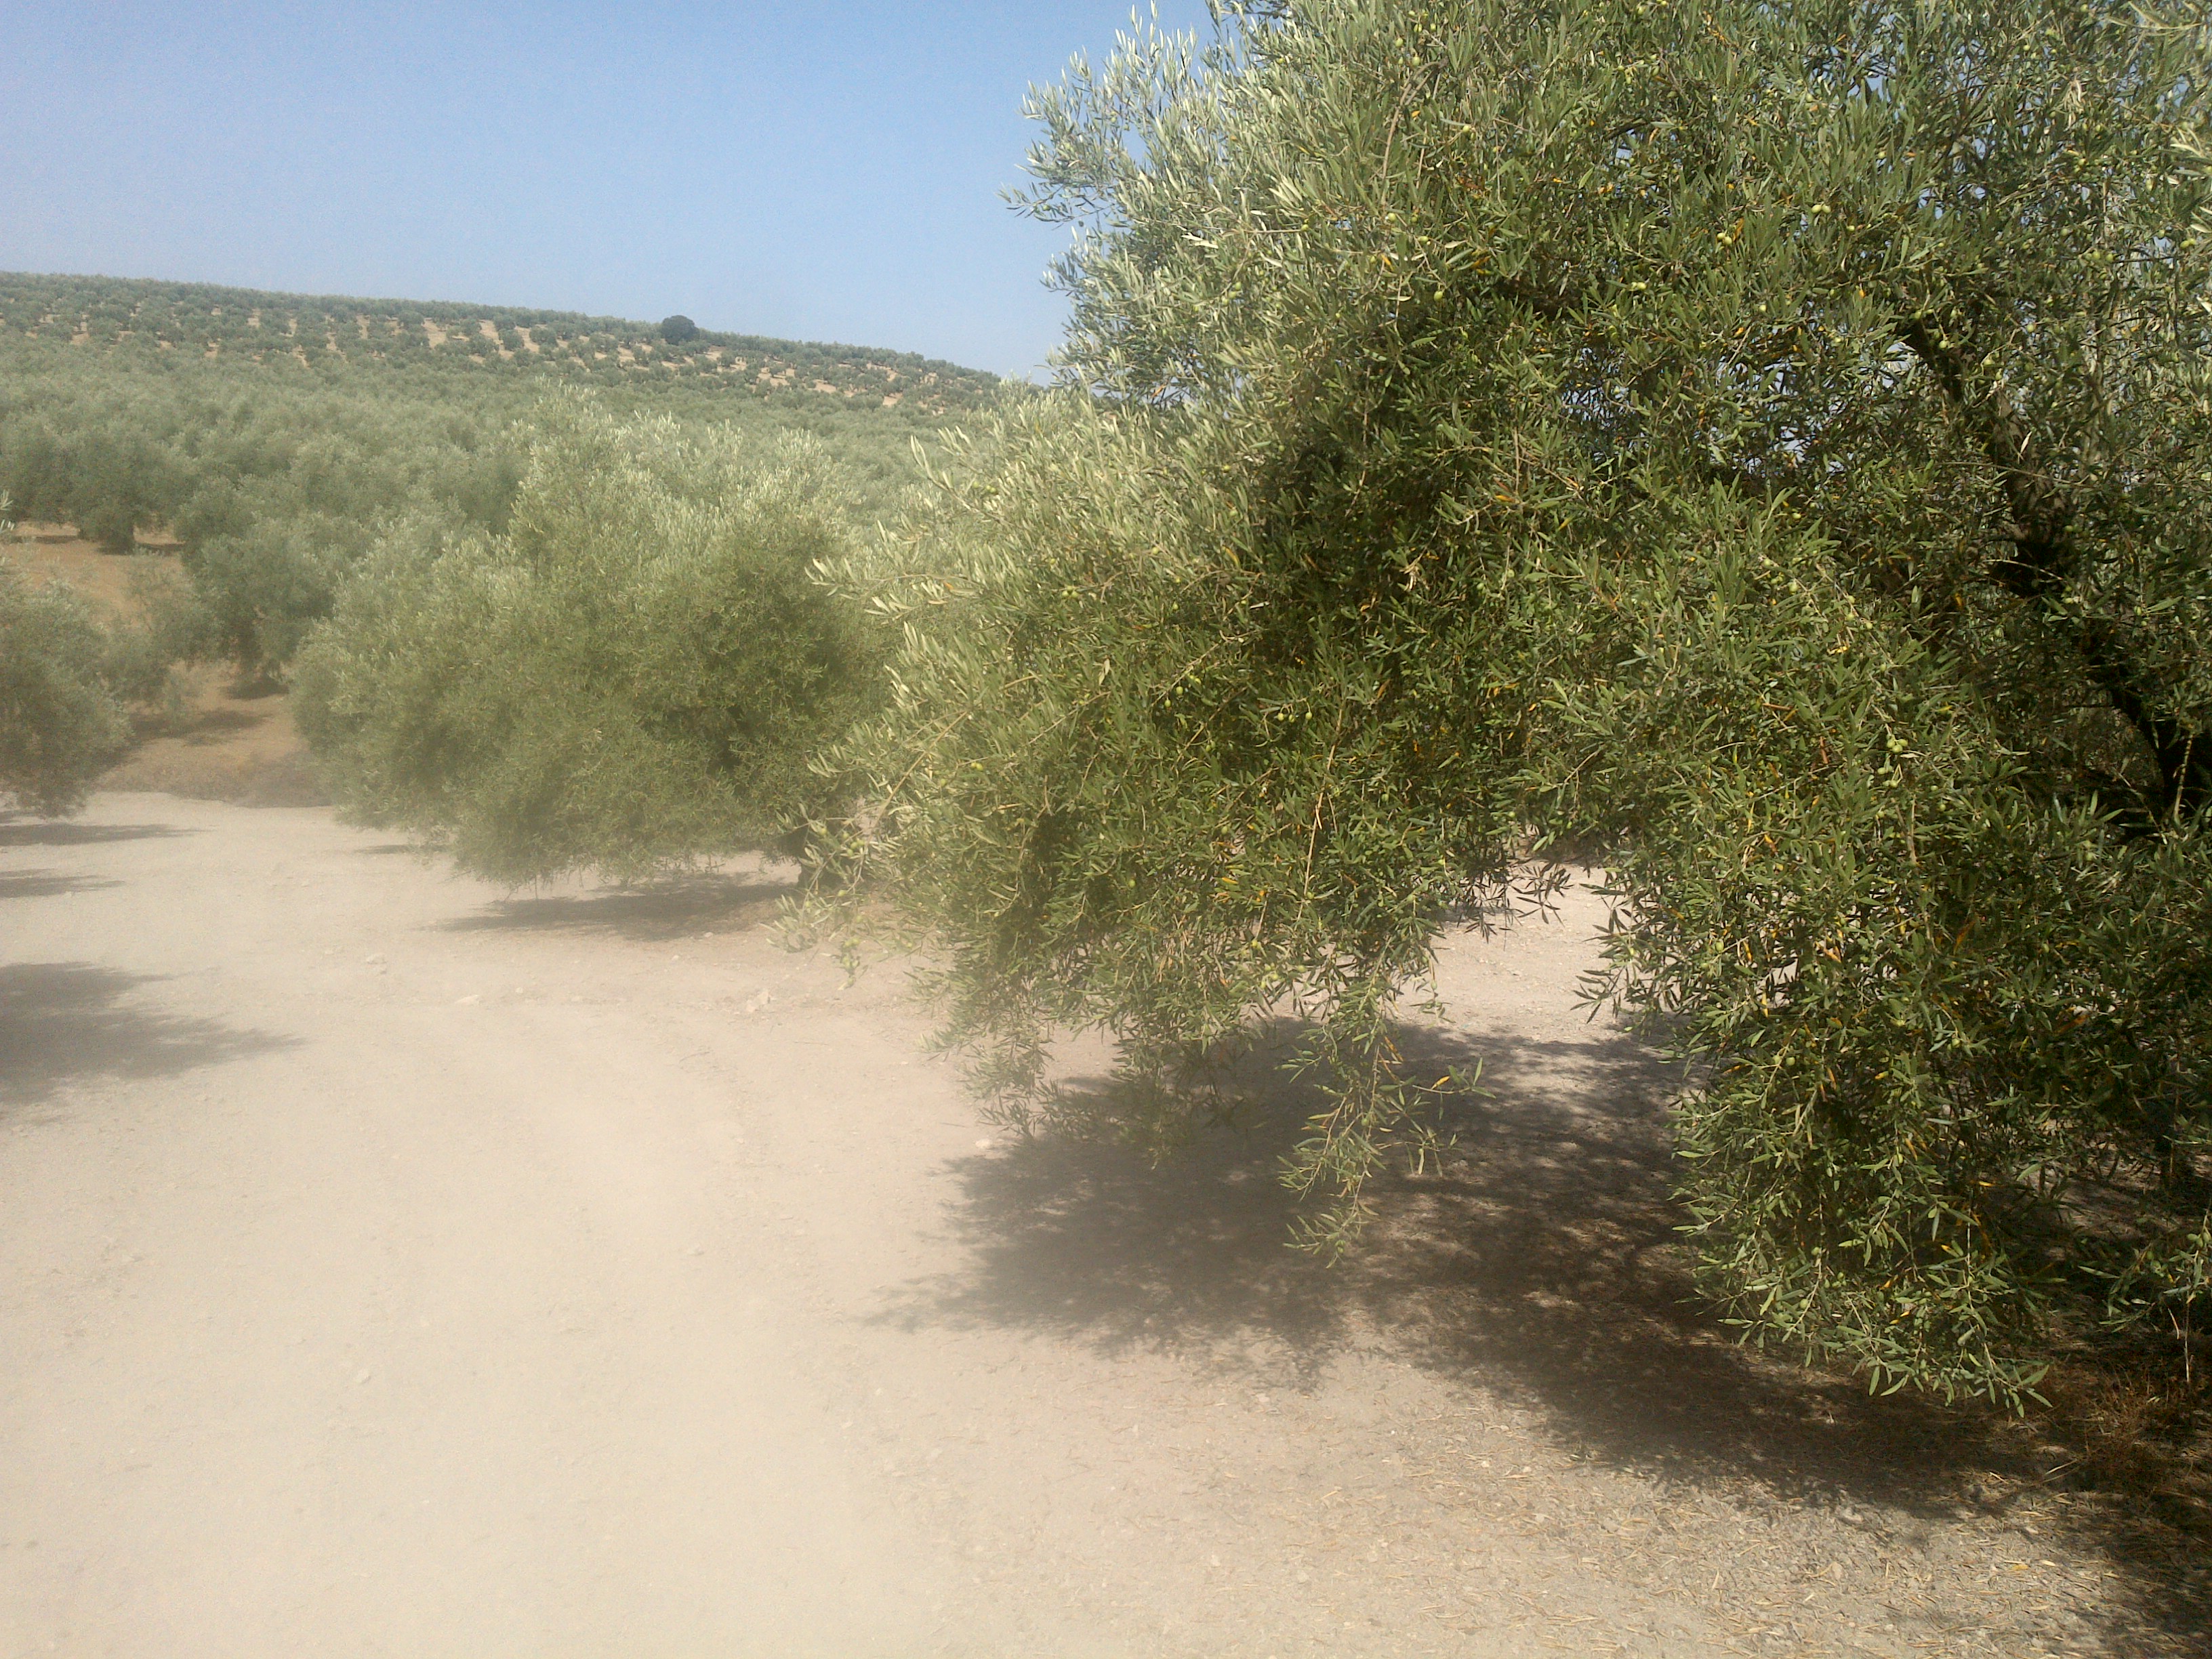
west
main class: Cropland
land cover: Olive groves
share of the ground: 50 - 75 %
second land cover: Other bare soil
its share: > 75 %
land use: Agriculture (excluding fallow land and kitchen gardens)
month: July
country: ES
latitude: 37.3958
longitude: -4.5408
